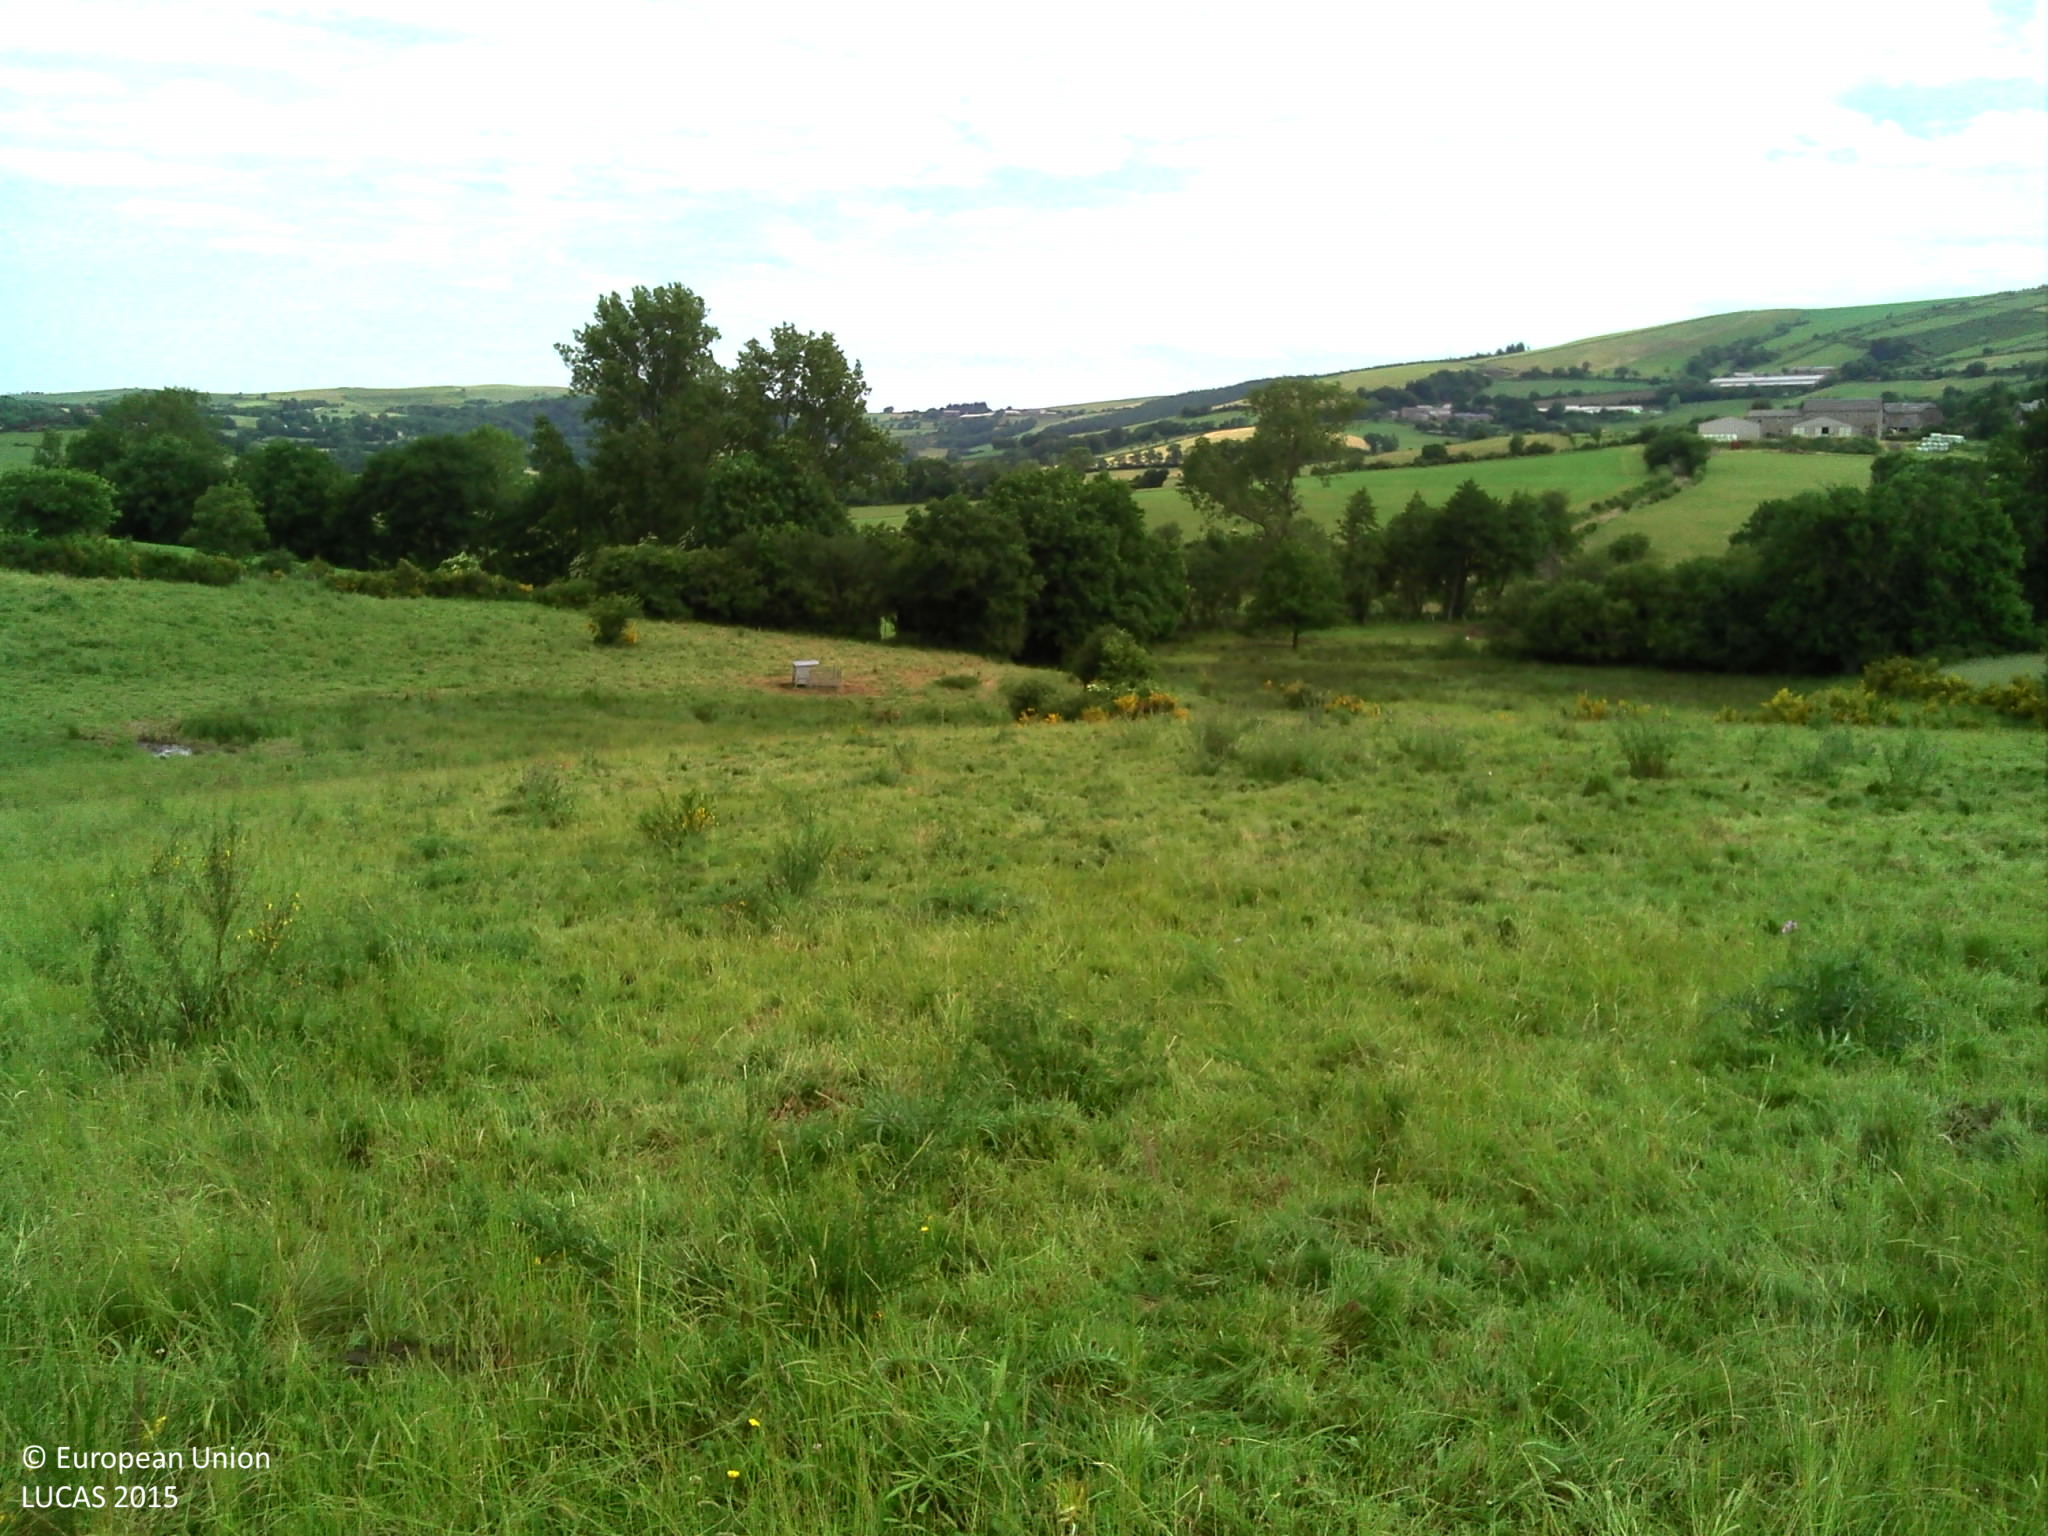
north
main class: Grassland
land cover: Grassland without tree/shrub cover
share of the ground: > 75 %
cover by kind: herbaceous plants 95 %, shrubs 5 %
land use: Agriculture (excluding fallow land and kitchen gardens)
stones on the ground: 10 - 25 %
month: June
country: FR
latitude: 44.2574
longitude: 2.9784
